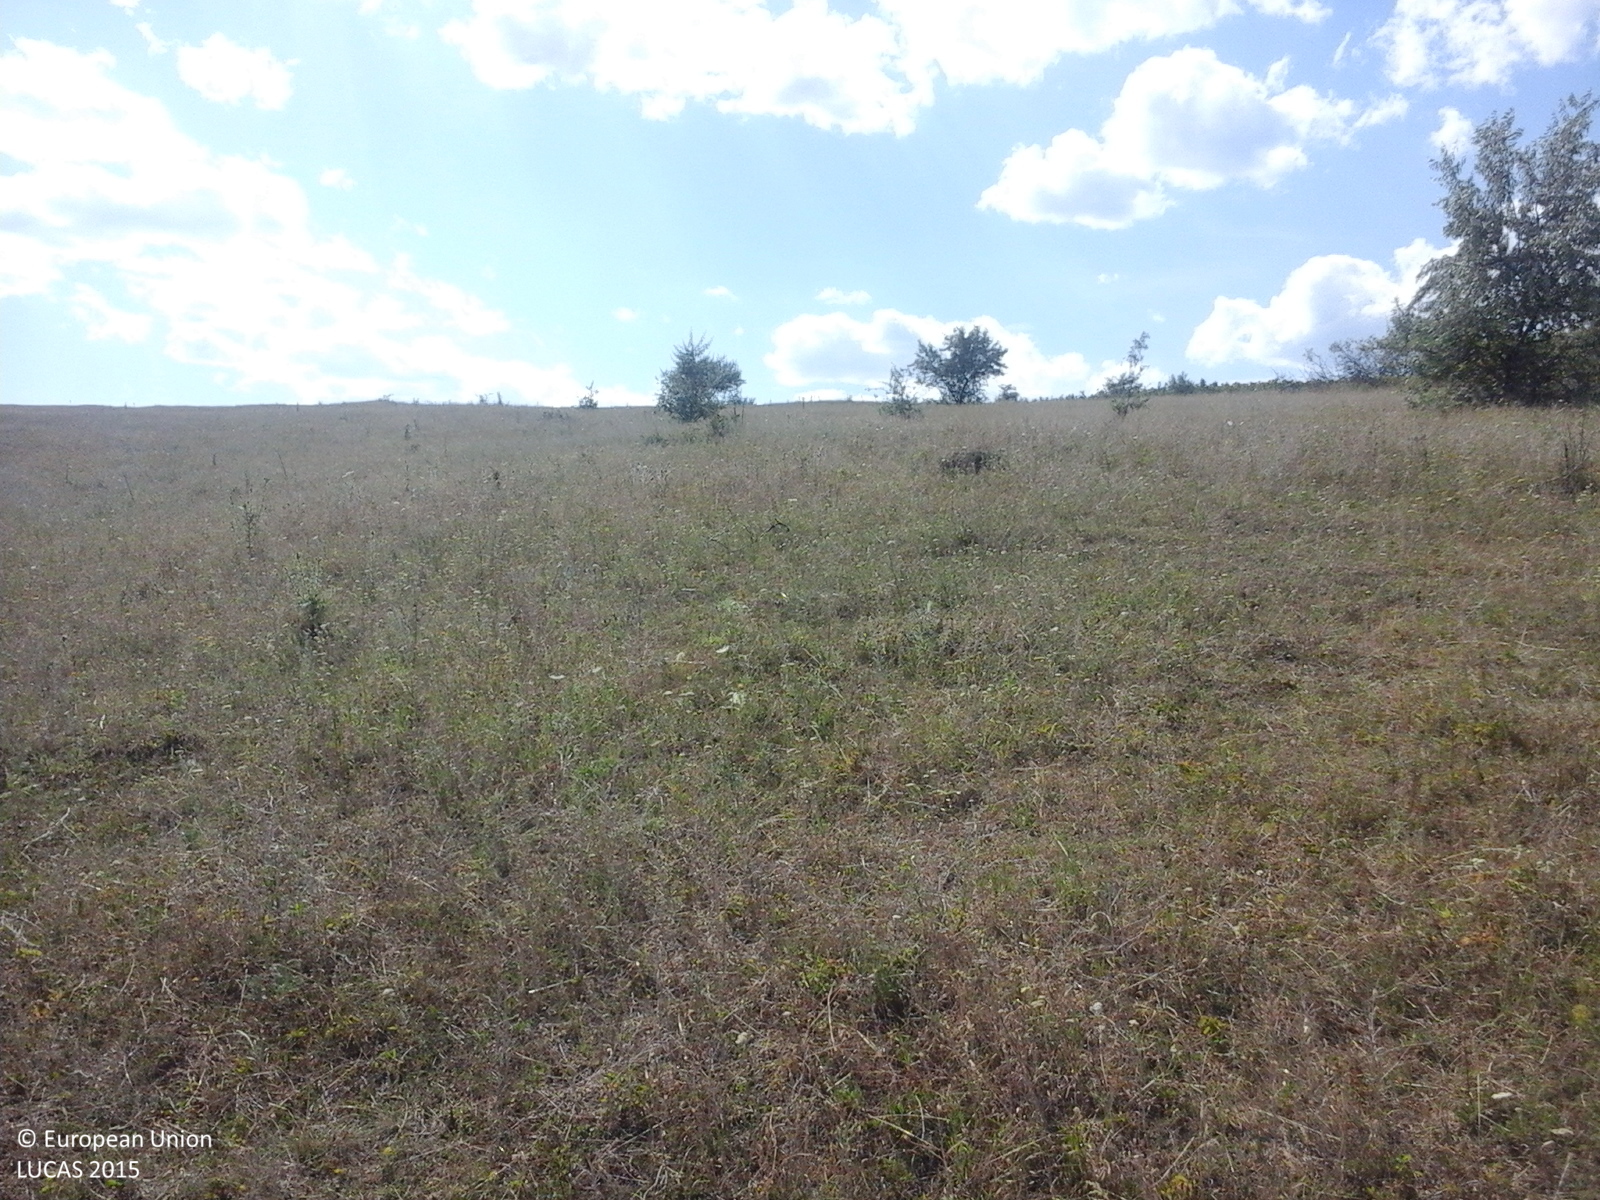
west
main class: Grassland
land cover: Grassland without tree/shrub cover
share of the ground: > 75 %
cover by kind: herbaceous plants 100 %
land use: Agriculture (excluding fallow land and kitchen gardens)
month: July
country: RO
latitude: 46.6076
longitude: 27.3810
